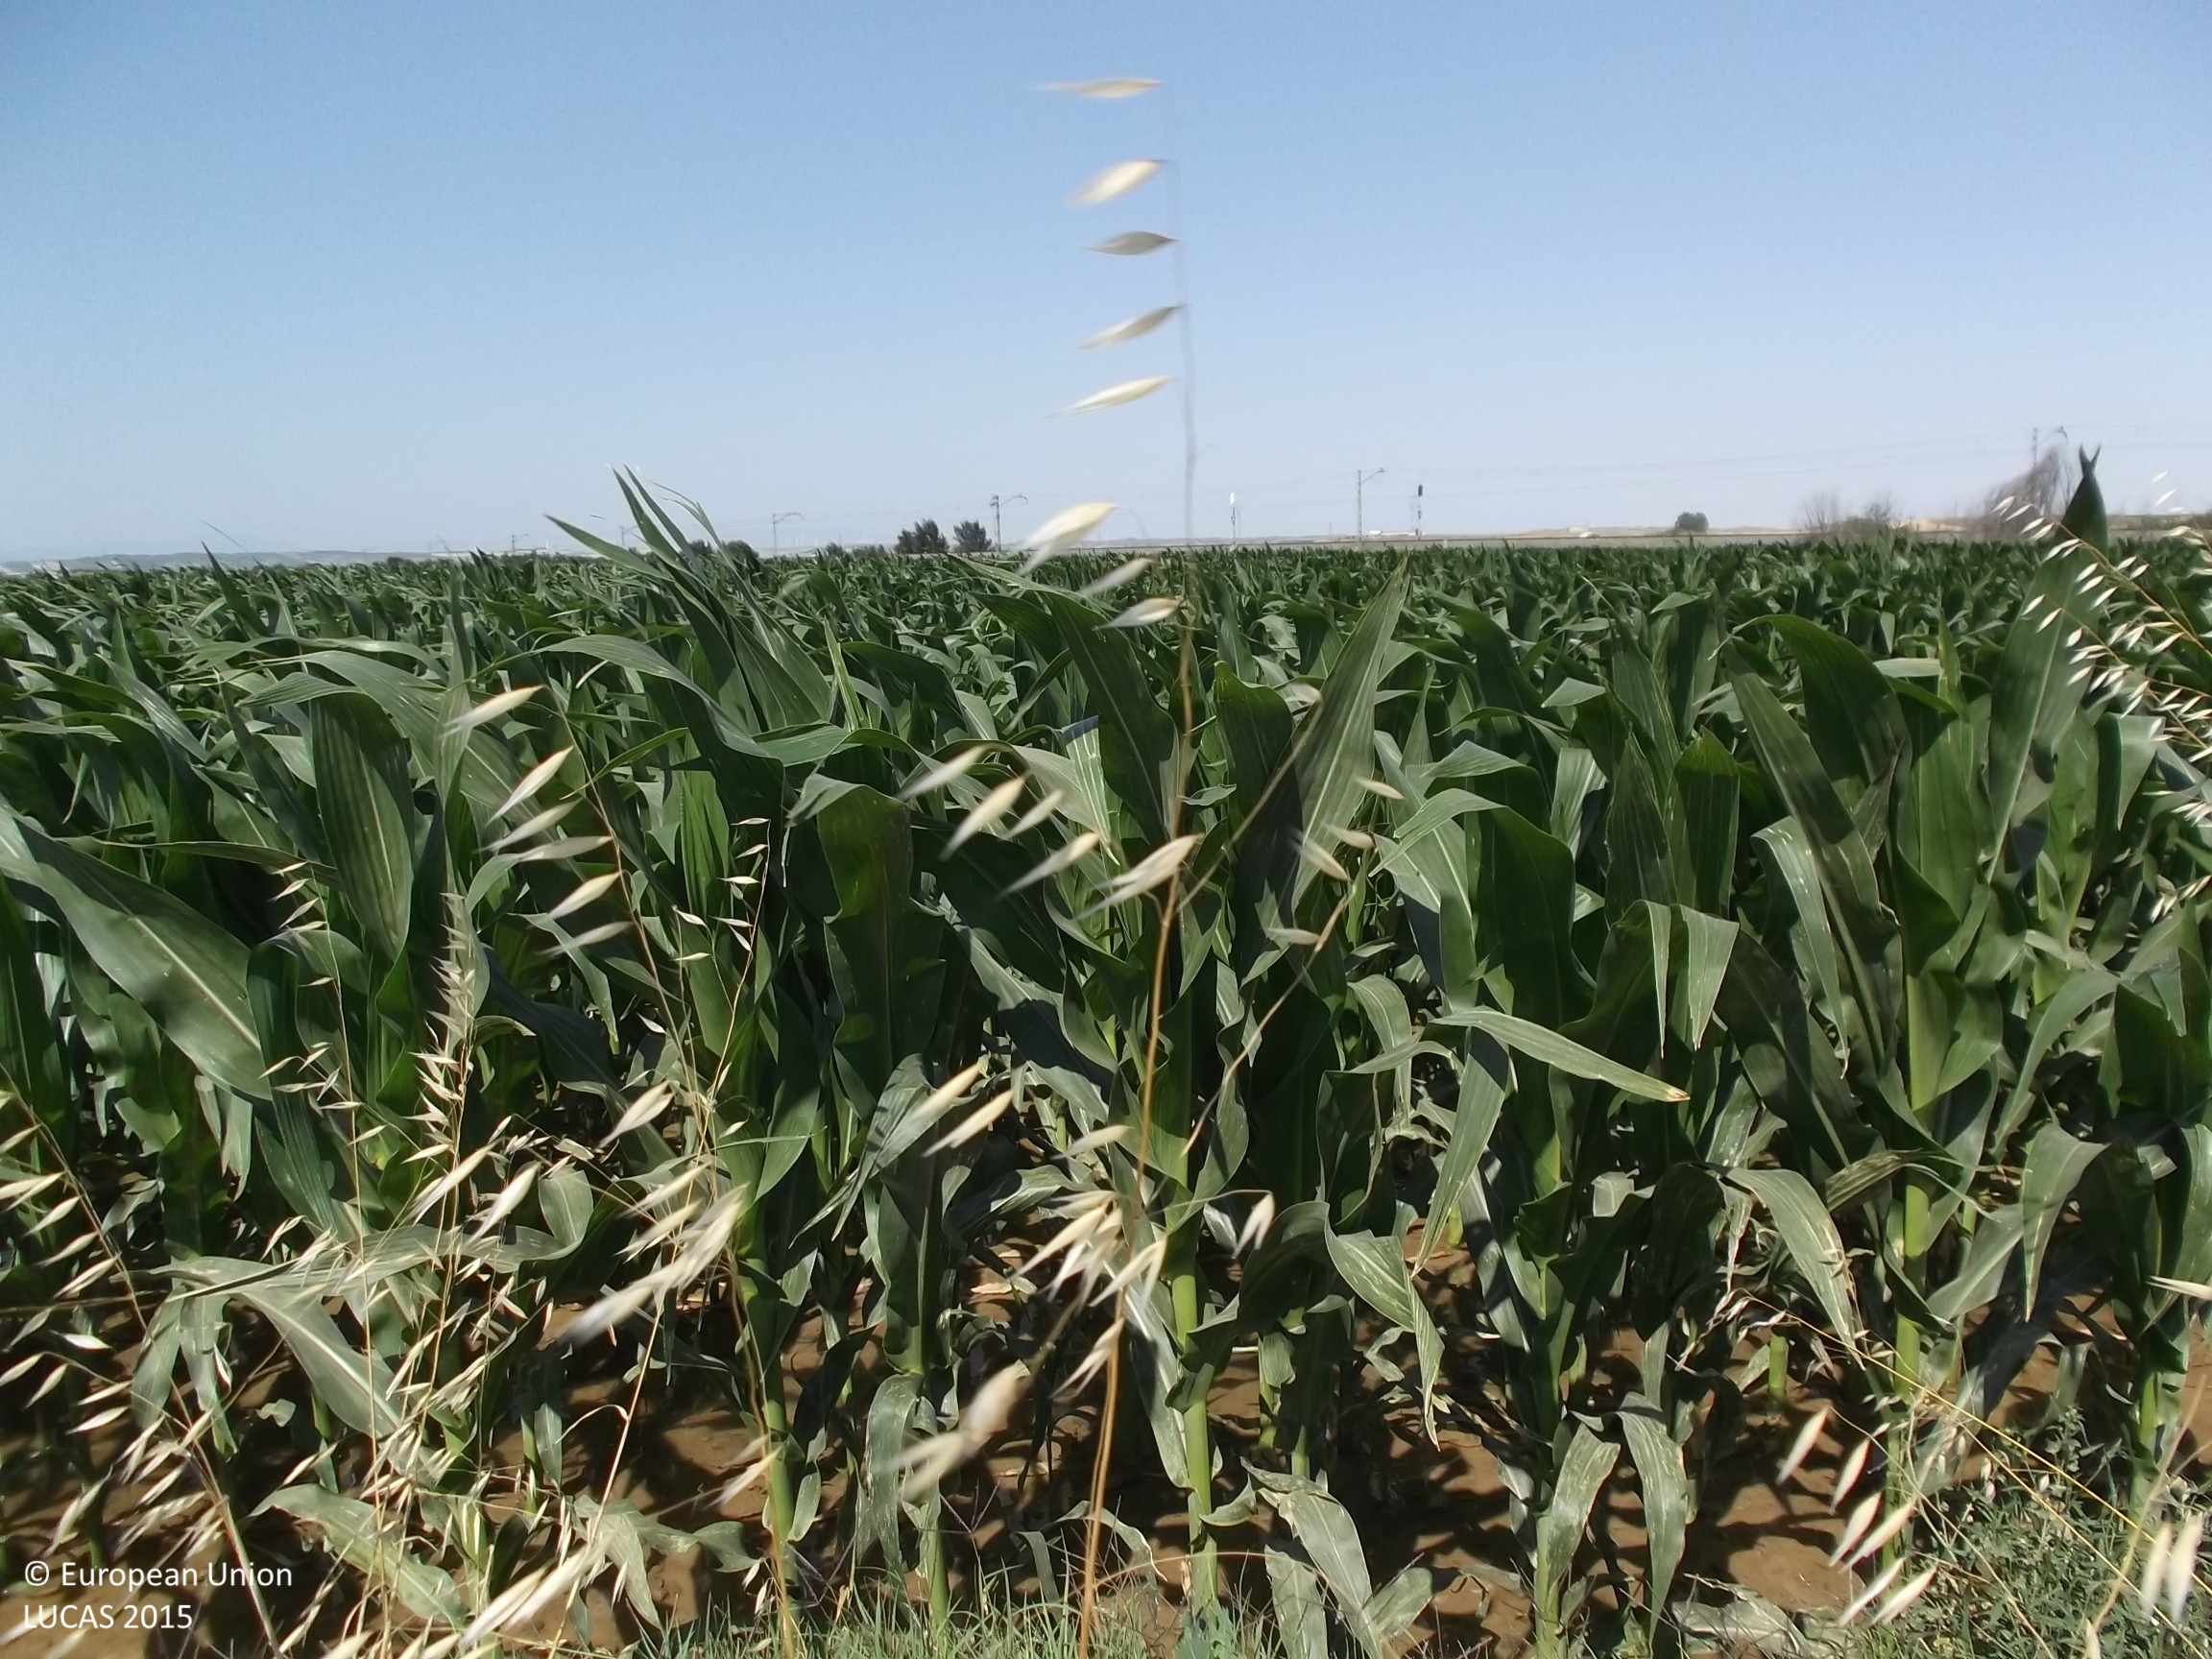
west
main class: Cropland
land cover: Maize
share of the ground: > 75 %
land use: Agriculture (excluding fallow land and kitchen gardens)
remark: Temporary flooded
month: July
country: ES
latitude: 42.3588
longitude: -1.6788
